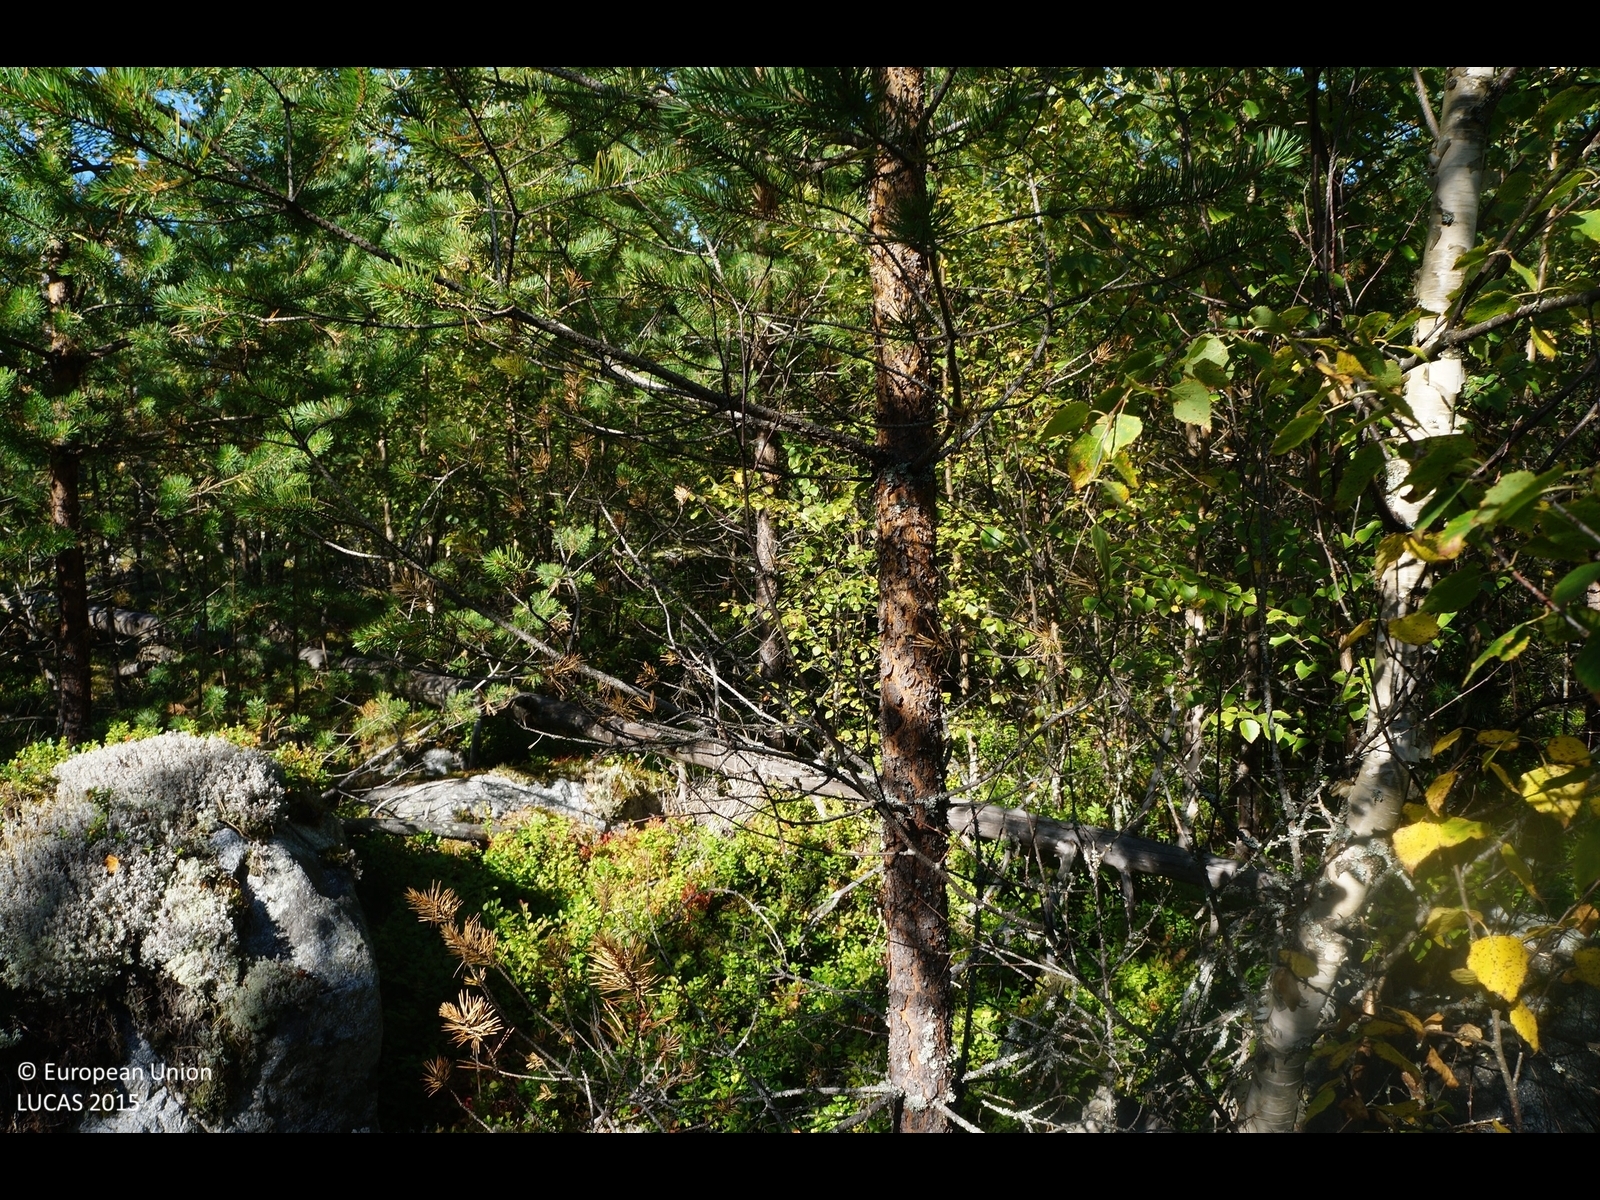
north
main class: Woodland
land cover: Pine dominated mixed woodland
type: boreal forest
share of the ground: 50 - 75 %
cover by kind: coniferous forest trees 50 %, broadleaved forest trees 20 %, shrubs 15 %, lichens and mosses 10 %, consolidated bare surface 5 %
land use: Forestry
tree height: > 5 m
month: August
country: FI
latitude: 63.7704
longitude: 22.7636
